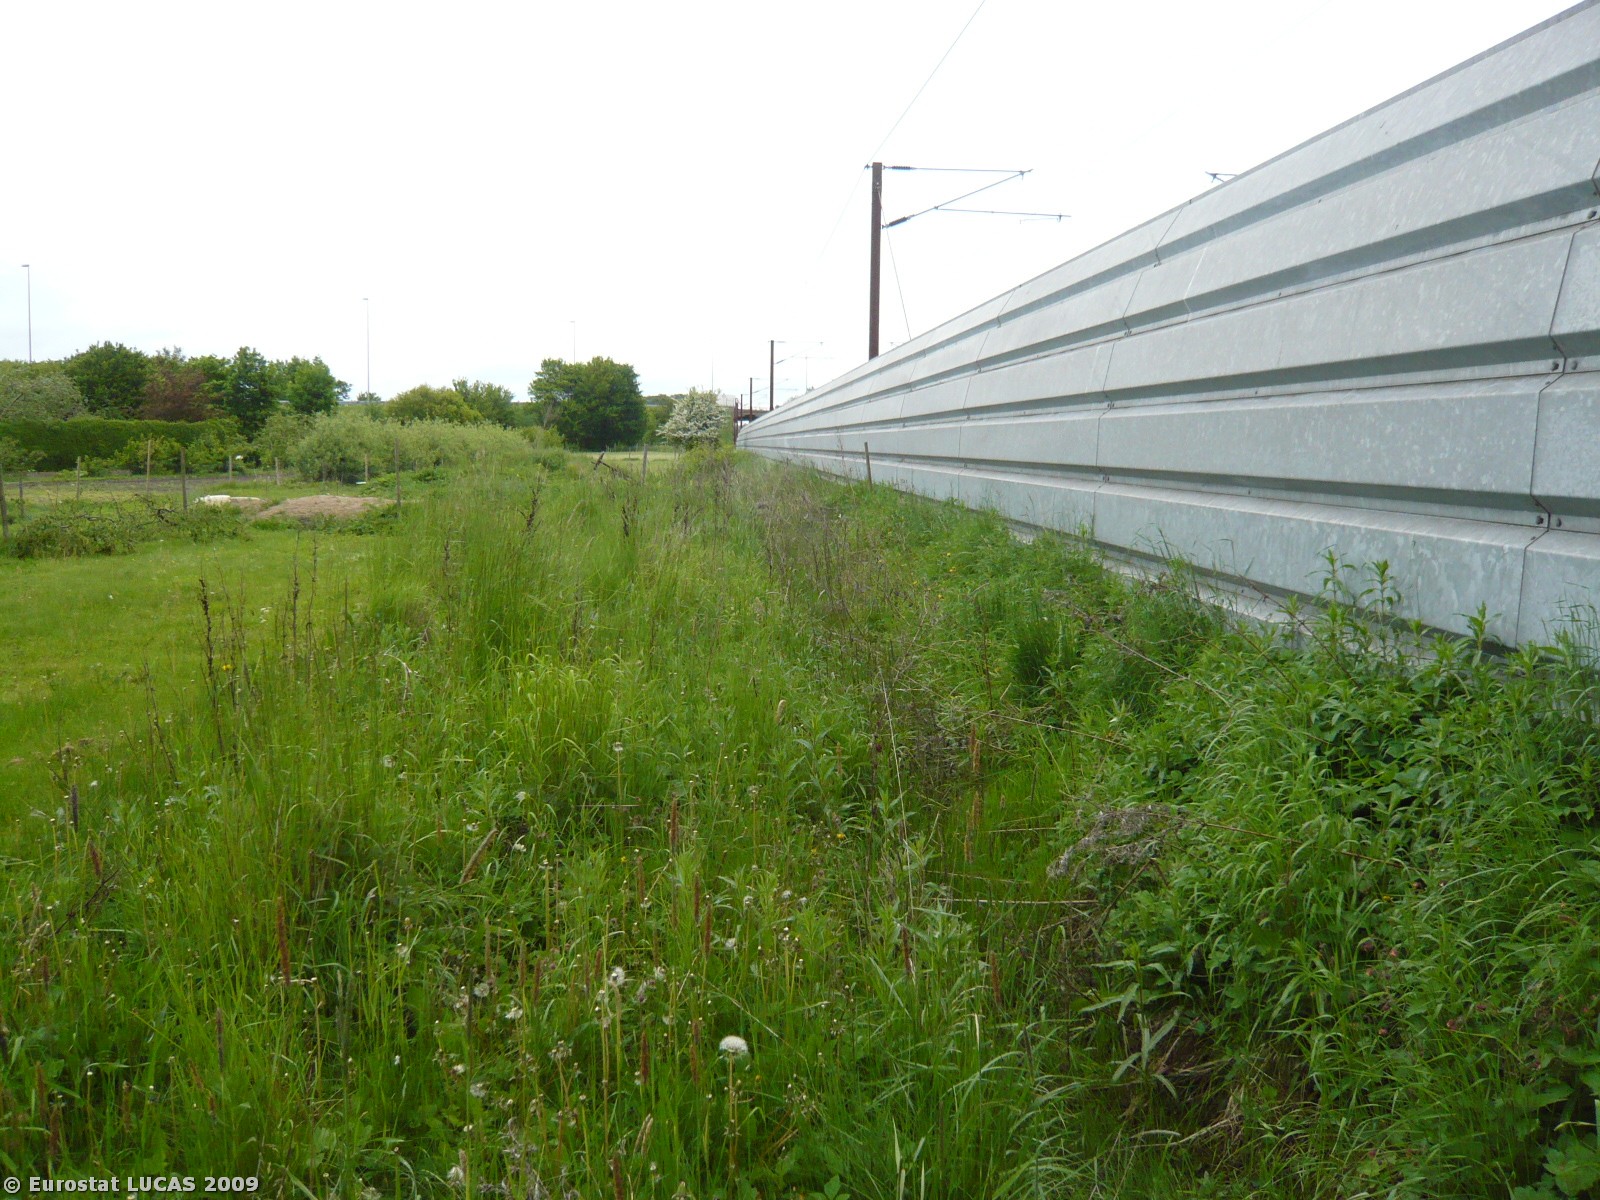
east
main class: Grassland
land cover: Grassland without tree/shrub cover
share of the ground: > 75 %
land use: Residential
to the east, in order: Grassland without tree/shrub cover; Artificial constructions; Railways; Grassland without tree/shrub cover; Tracks; Grass margins; Common wheat
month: May
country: DK
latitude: 55.4399
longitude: 11.6583
